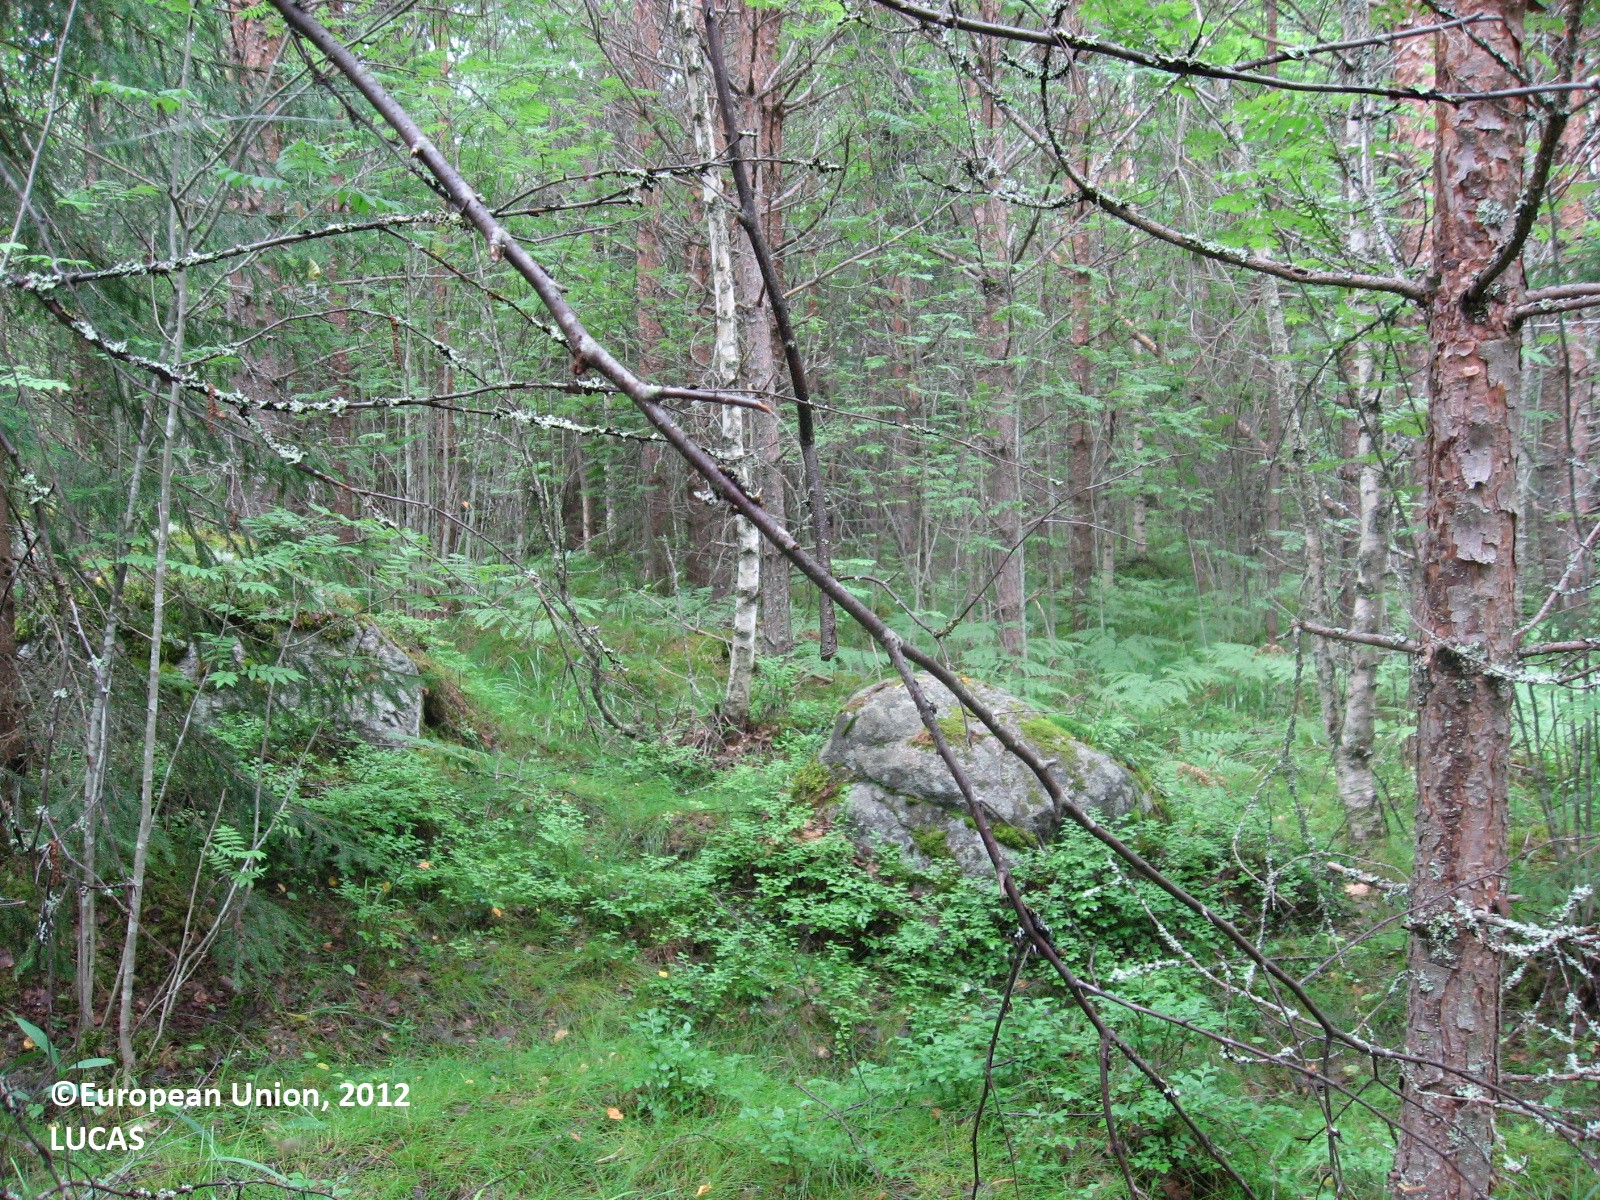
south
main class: Woodland
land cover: Pine dominated mixed woodland
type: boreal forest
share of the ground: > 75 %
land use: Forestry
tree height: > 5 m
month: July
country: FI
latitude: 61.0698
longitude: 25.7913
